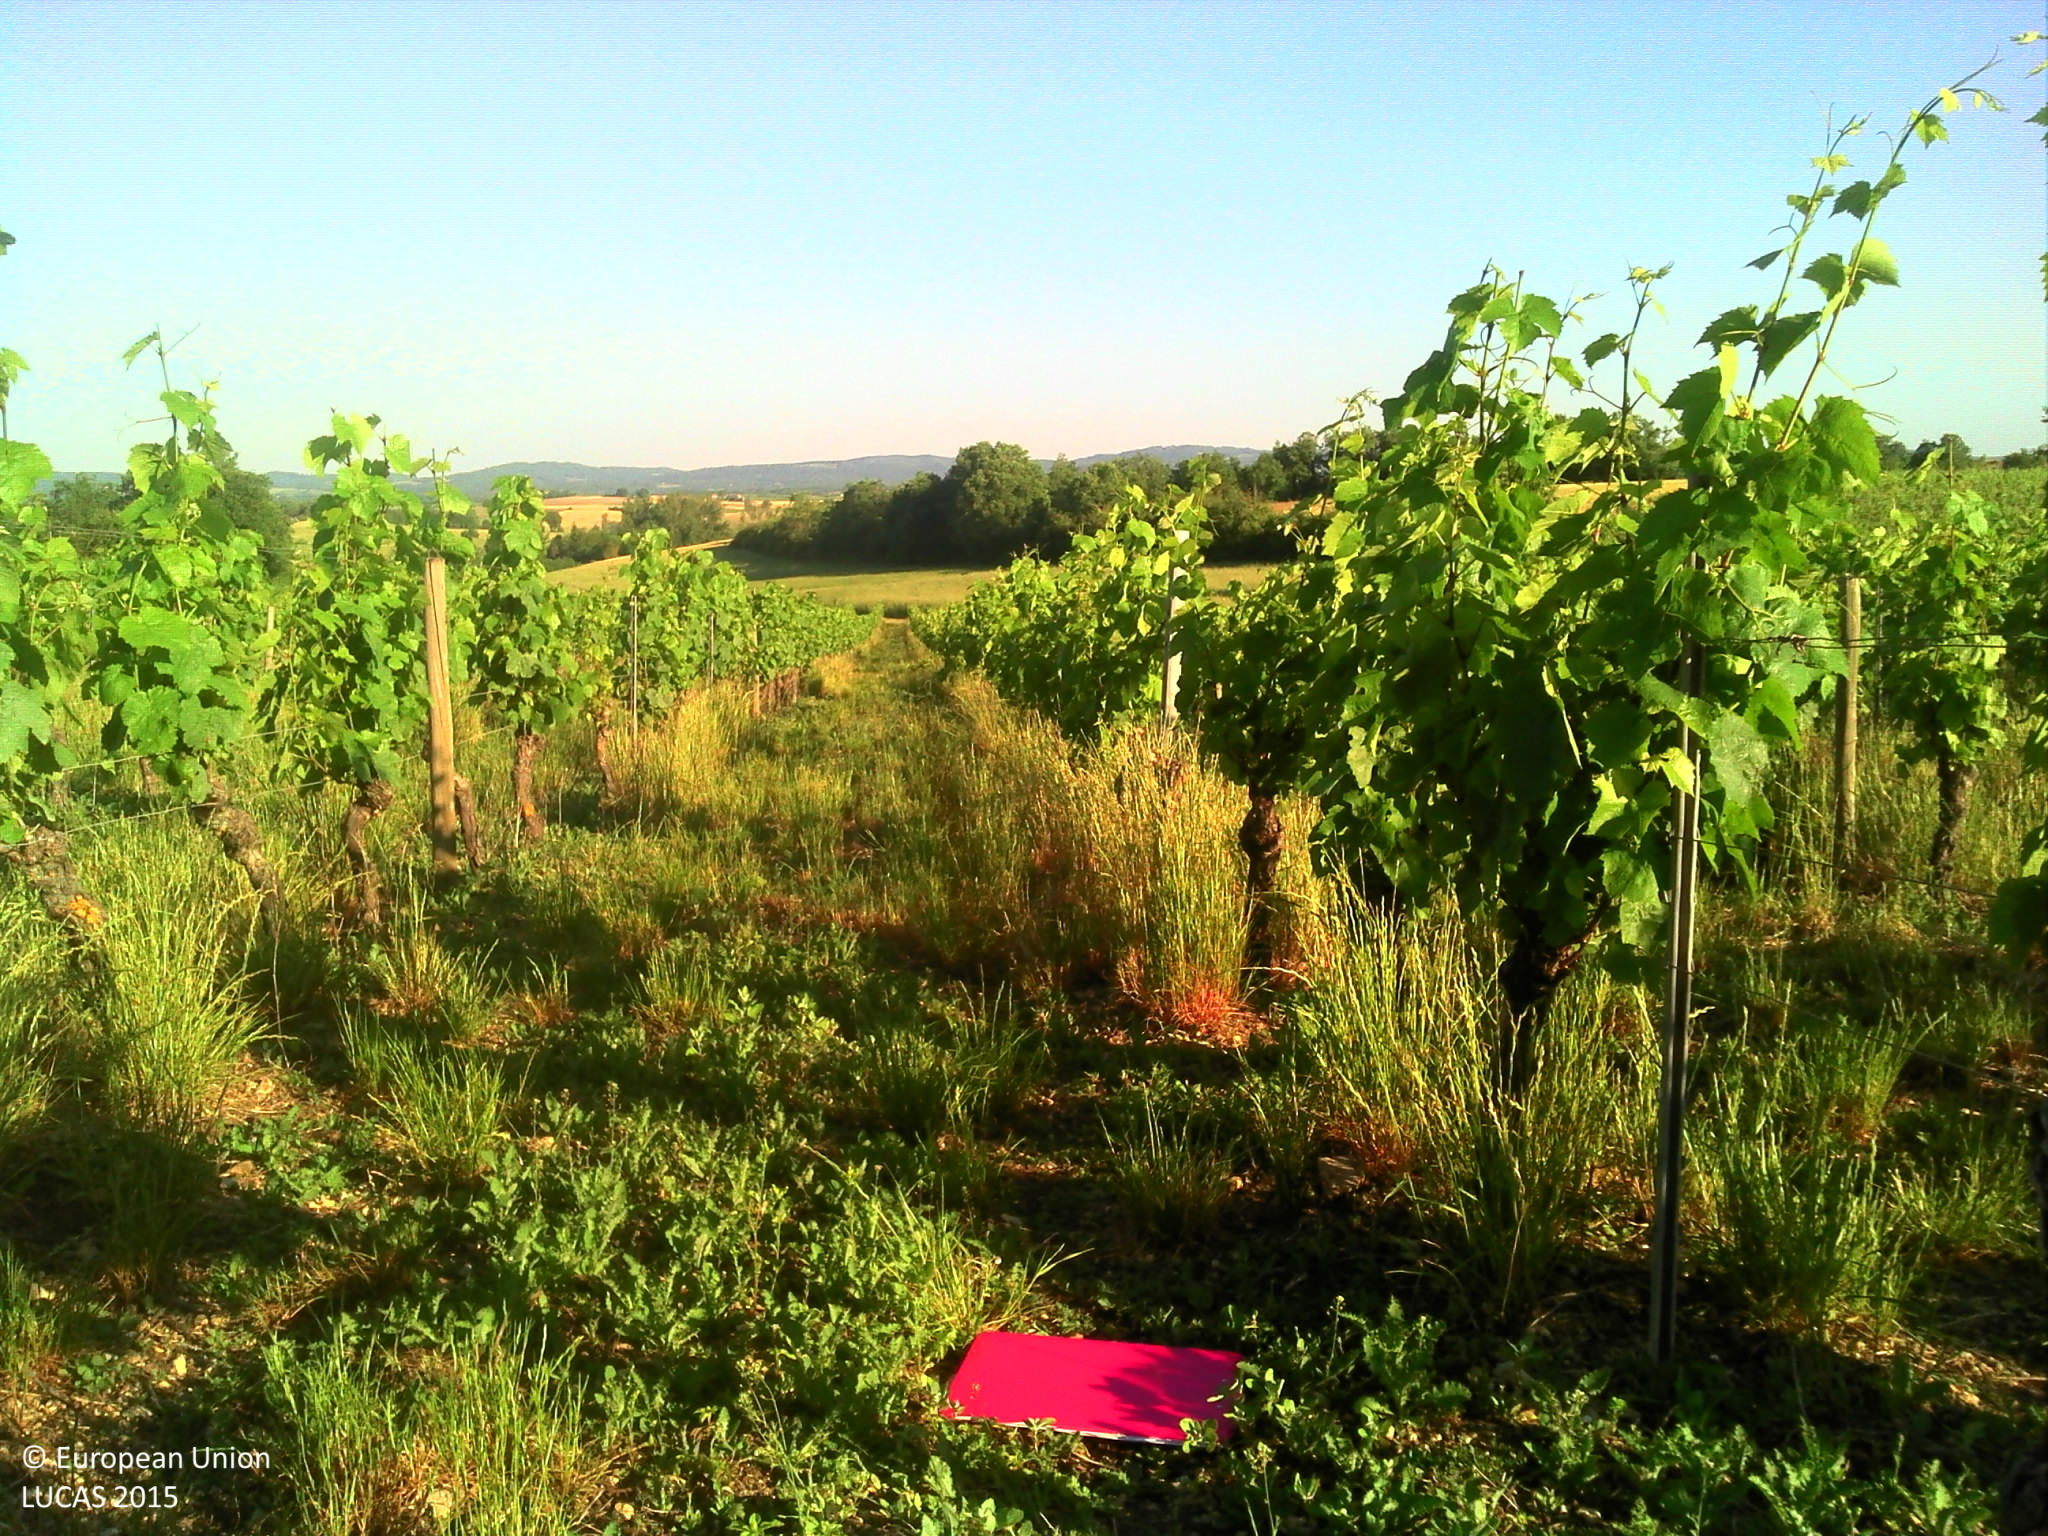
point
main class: Cropland
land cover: Vineyards
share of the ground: 10 - 25 %
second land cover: Spontaneously vegetated surfaces
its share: > 75 %
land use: Agriculture (excluding fallow land and kitchen gardens)
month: June
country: FR
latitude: 44.0179
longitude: 1.9315
